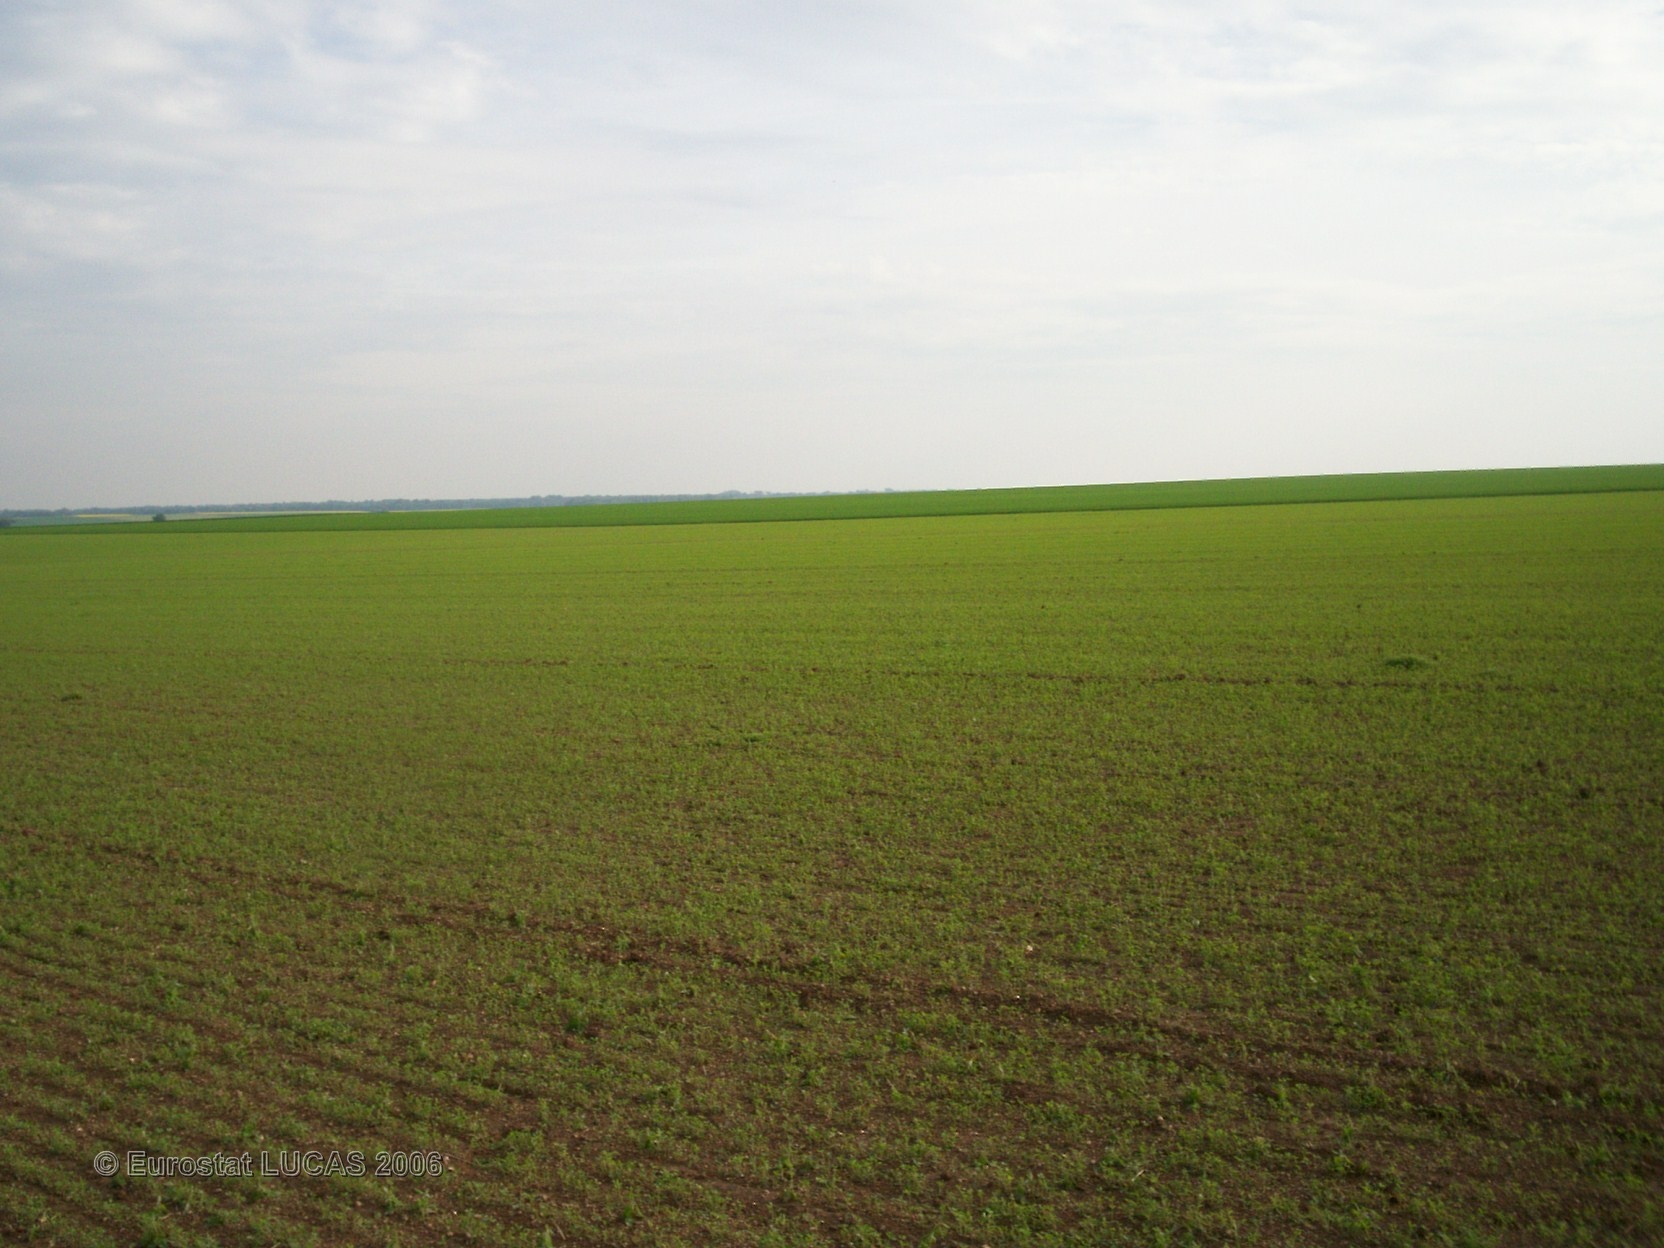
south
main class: Cropland
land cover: Lucerne
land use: Agriculture (excluding fallow land and kitchen gardens)
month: May
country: FR
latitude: 49.1792
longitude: 4.3579
